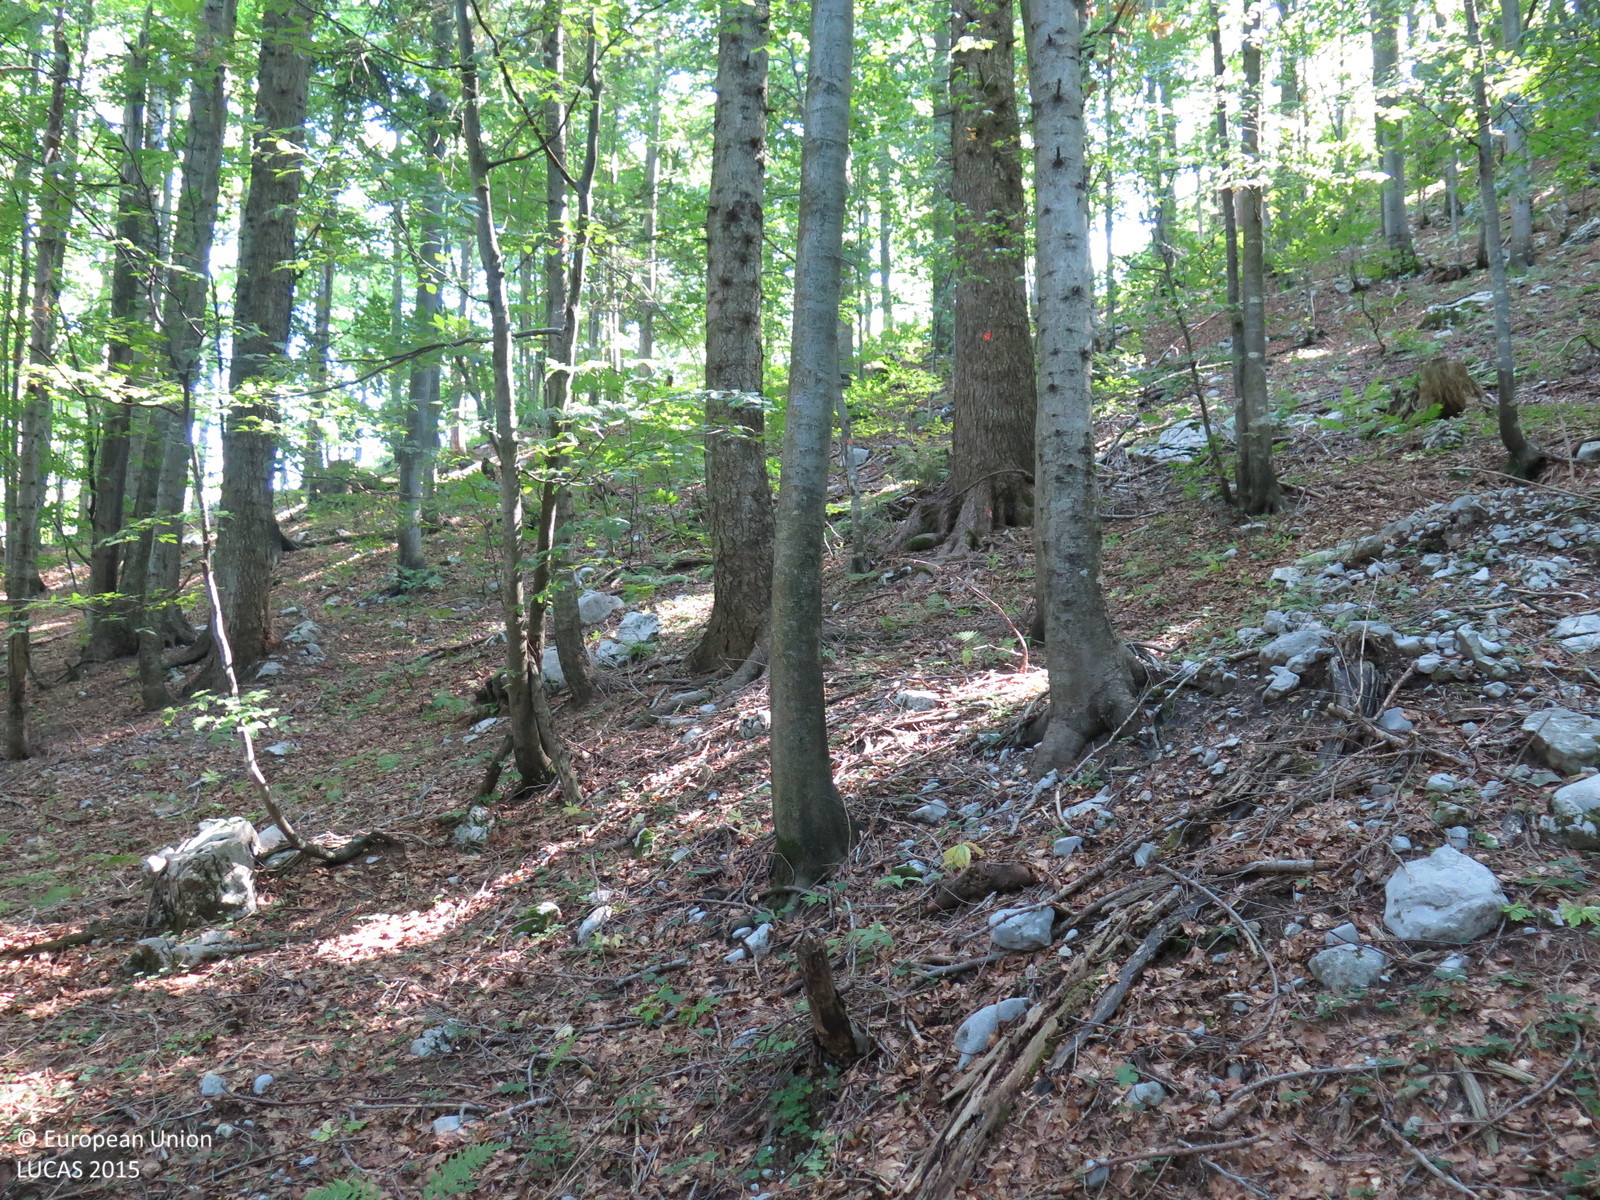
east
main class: Woodland
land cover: Other mixed woodland
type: mountainous beech forest
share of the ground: > 75 %
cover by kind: broadleaved forest trees 75 %, coniferous forest trees 25 %
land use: Forestry
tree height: > 5 m
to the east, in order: Other mixed woodland; Broadleaved woodland
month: September
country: HR
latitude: 45.5352
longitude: 14.4902
